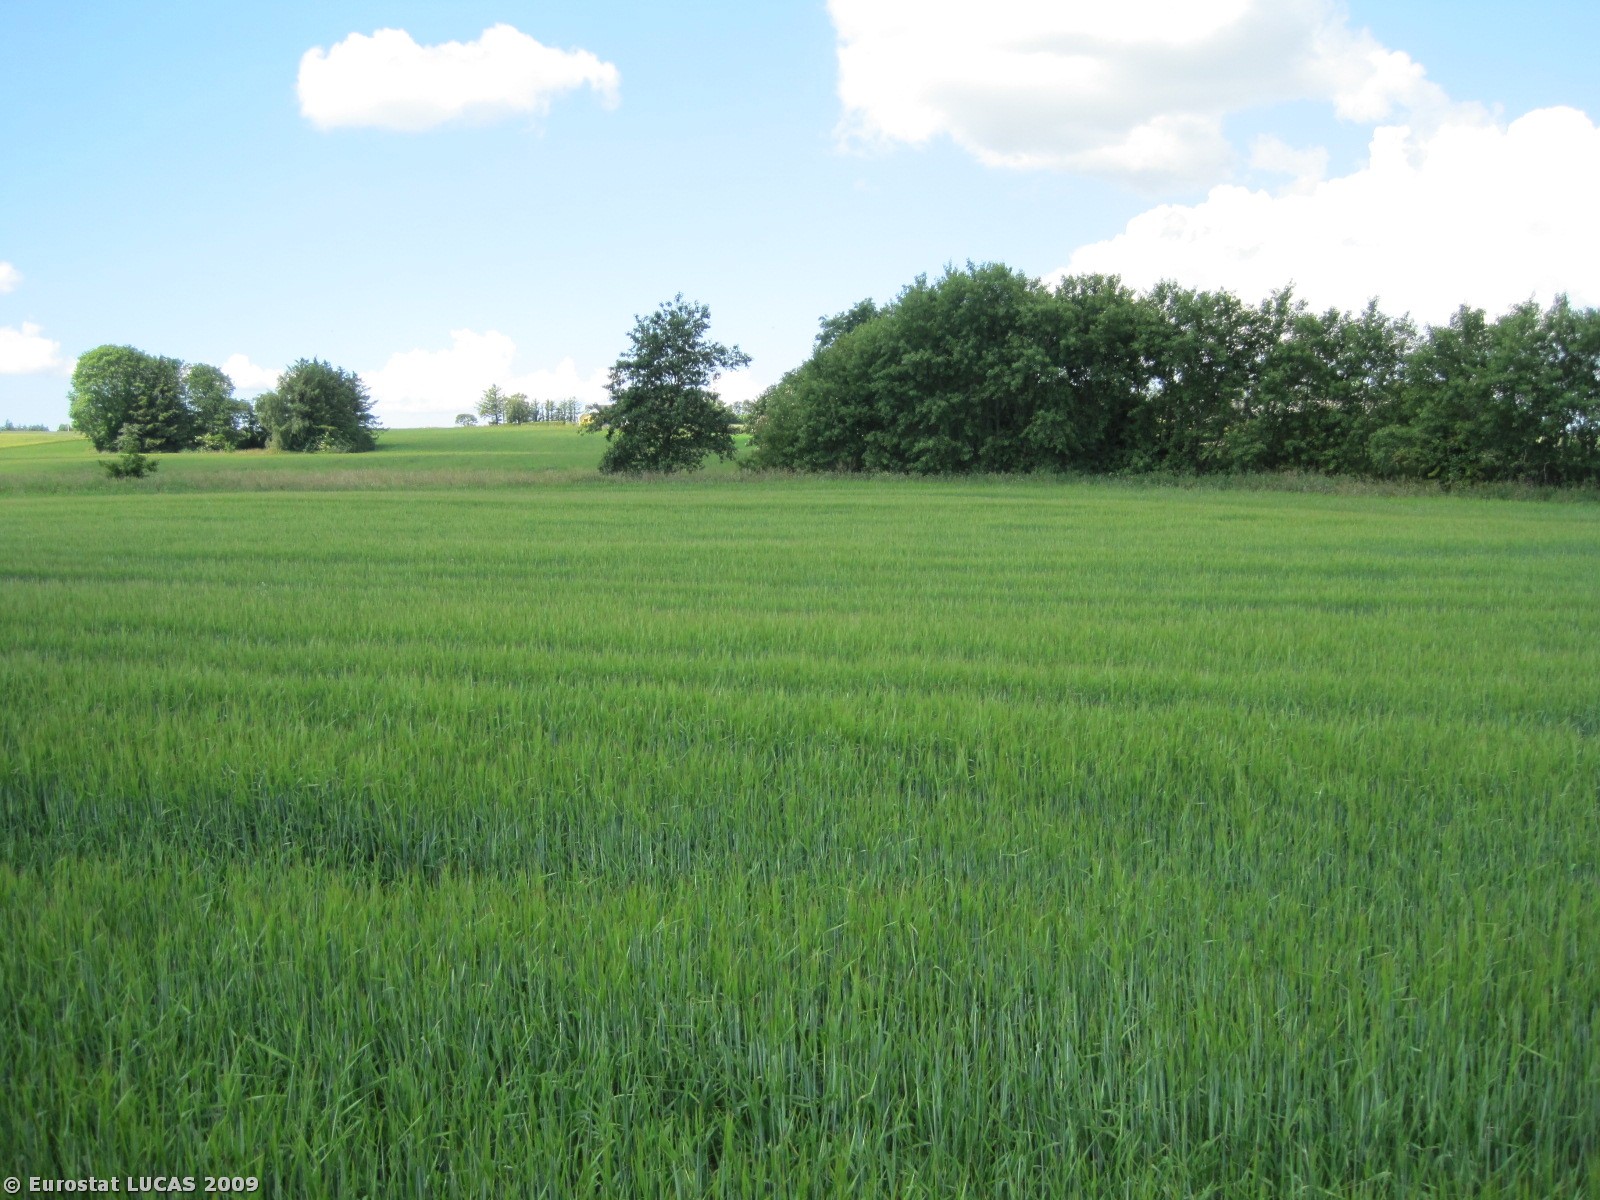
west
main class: Cropland
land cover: Barley
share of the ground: > 75 %
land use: Agriculture (excluding fallow land and kitchen gardens)
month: June
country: DK
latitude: 56.6511
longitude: 8.9738
